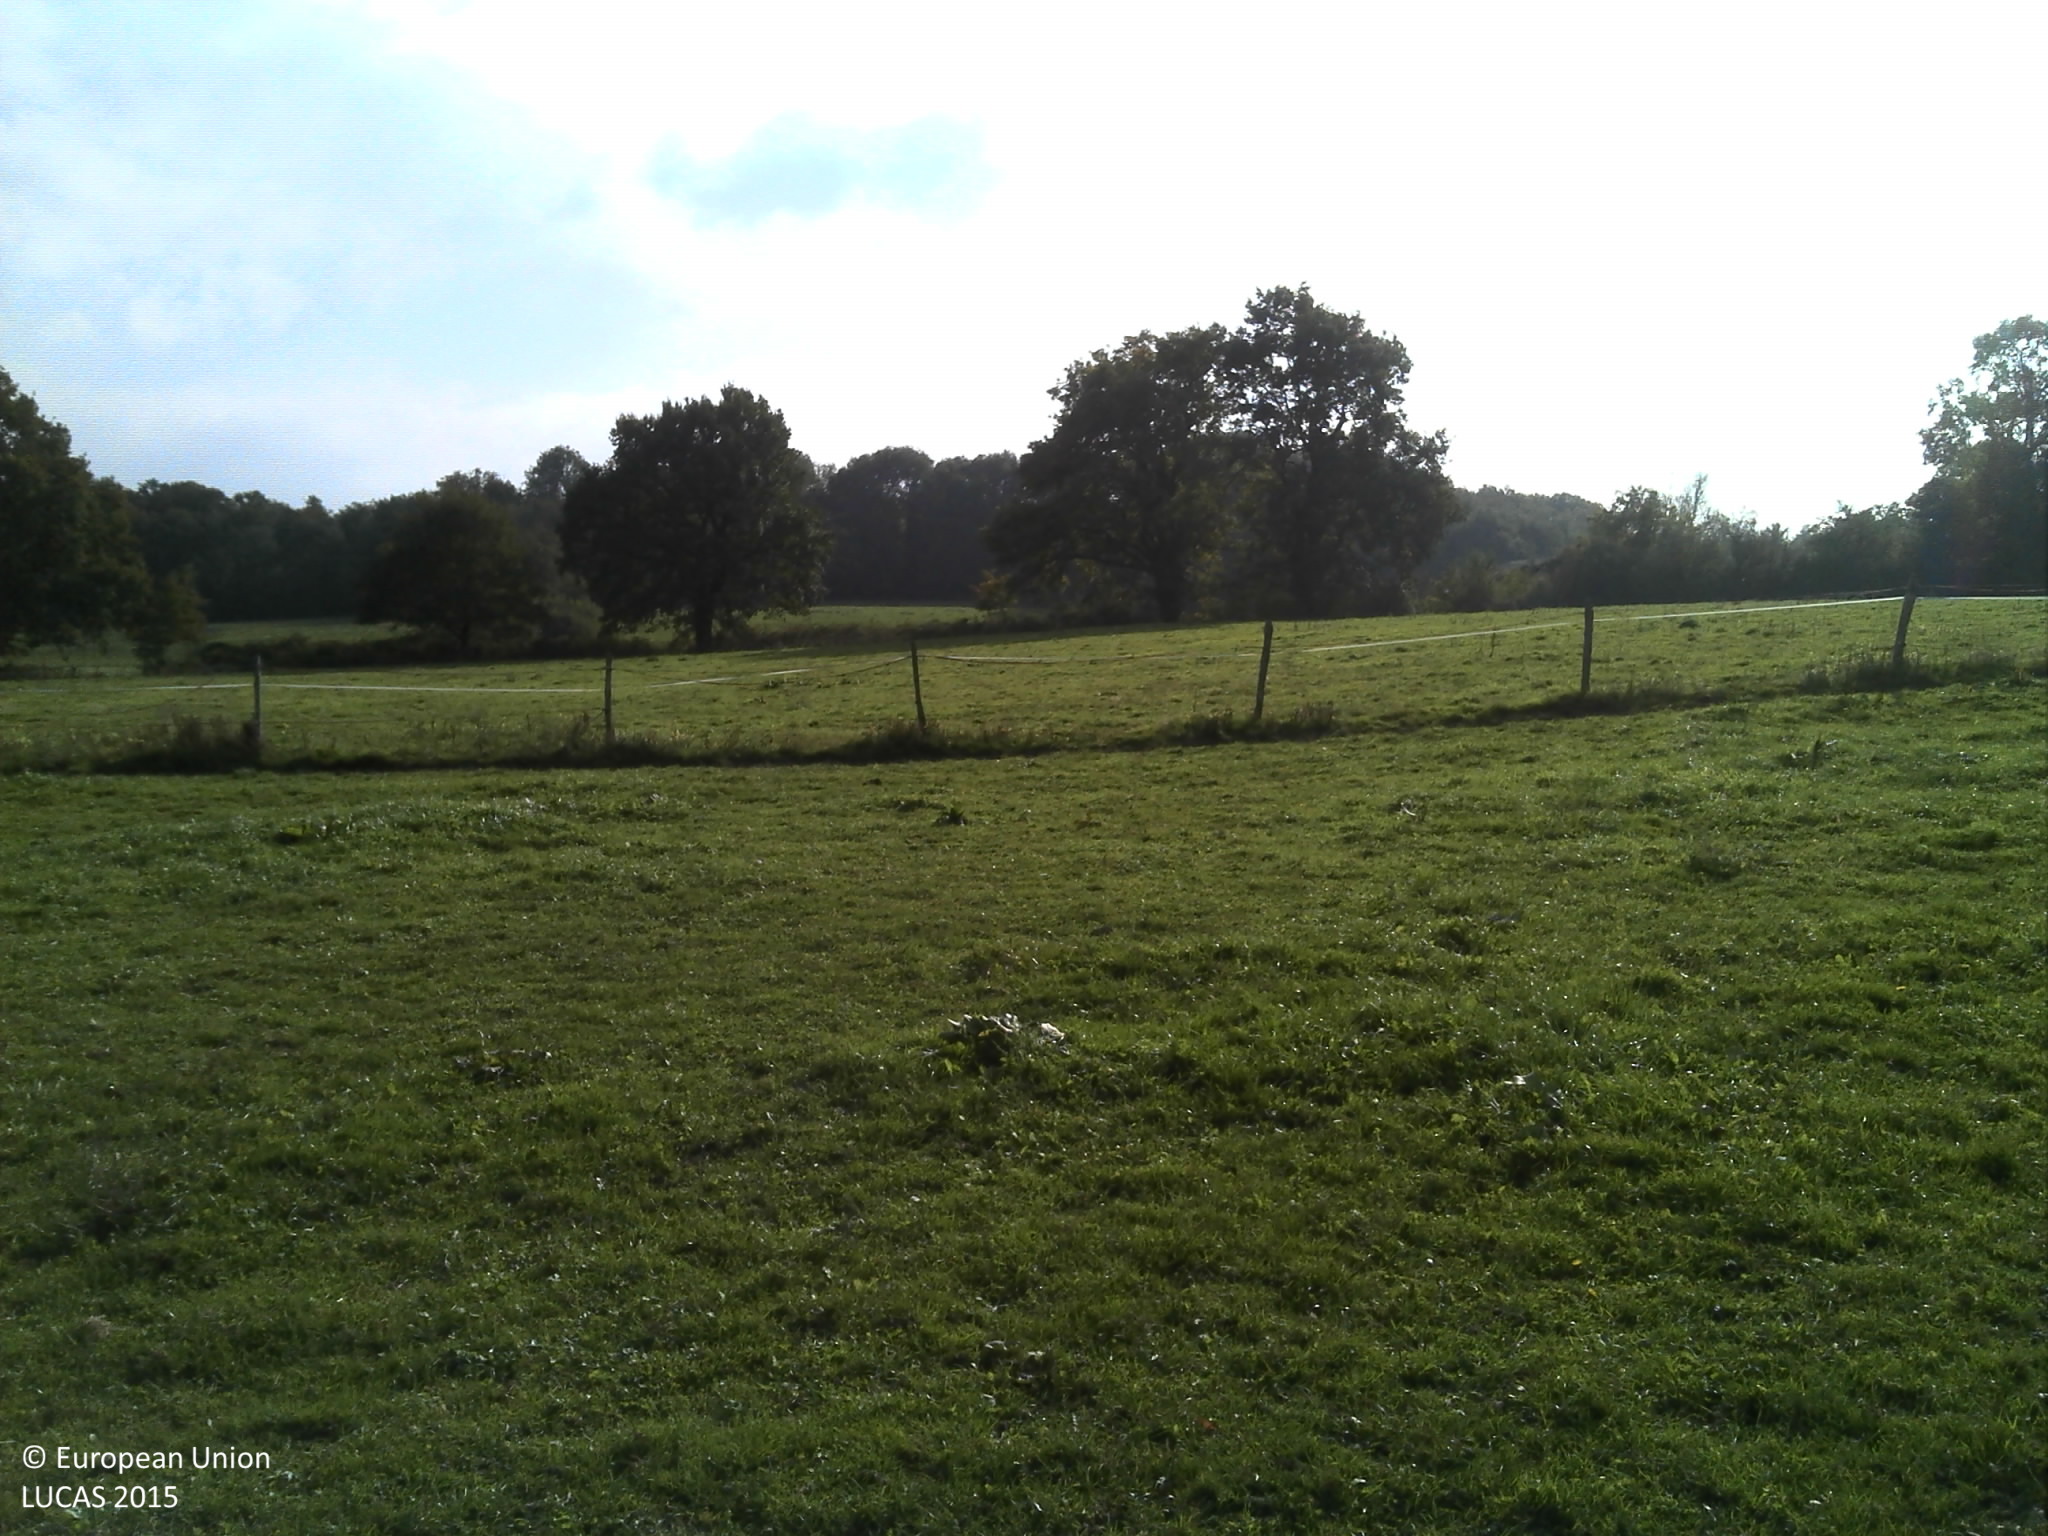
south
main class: Grassland
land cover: Grassland without tree/shrub cover
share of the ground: > 75 %
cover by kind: herbaceous plants 100 %
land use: Agriculture (excluding fallow land and kitchen gardens)
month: October
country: FR
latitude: 46.2668
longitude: 5.3190
